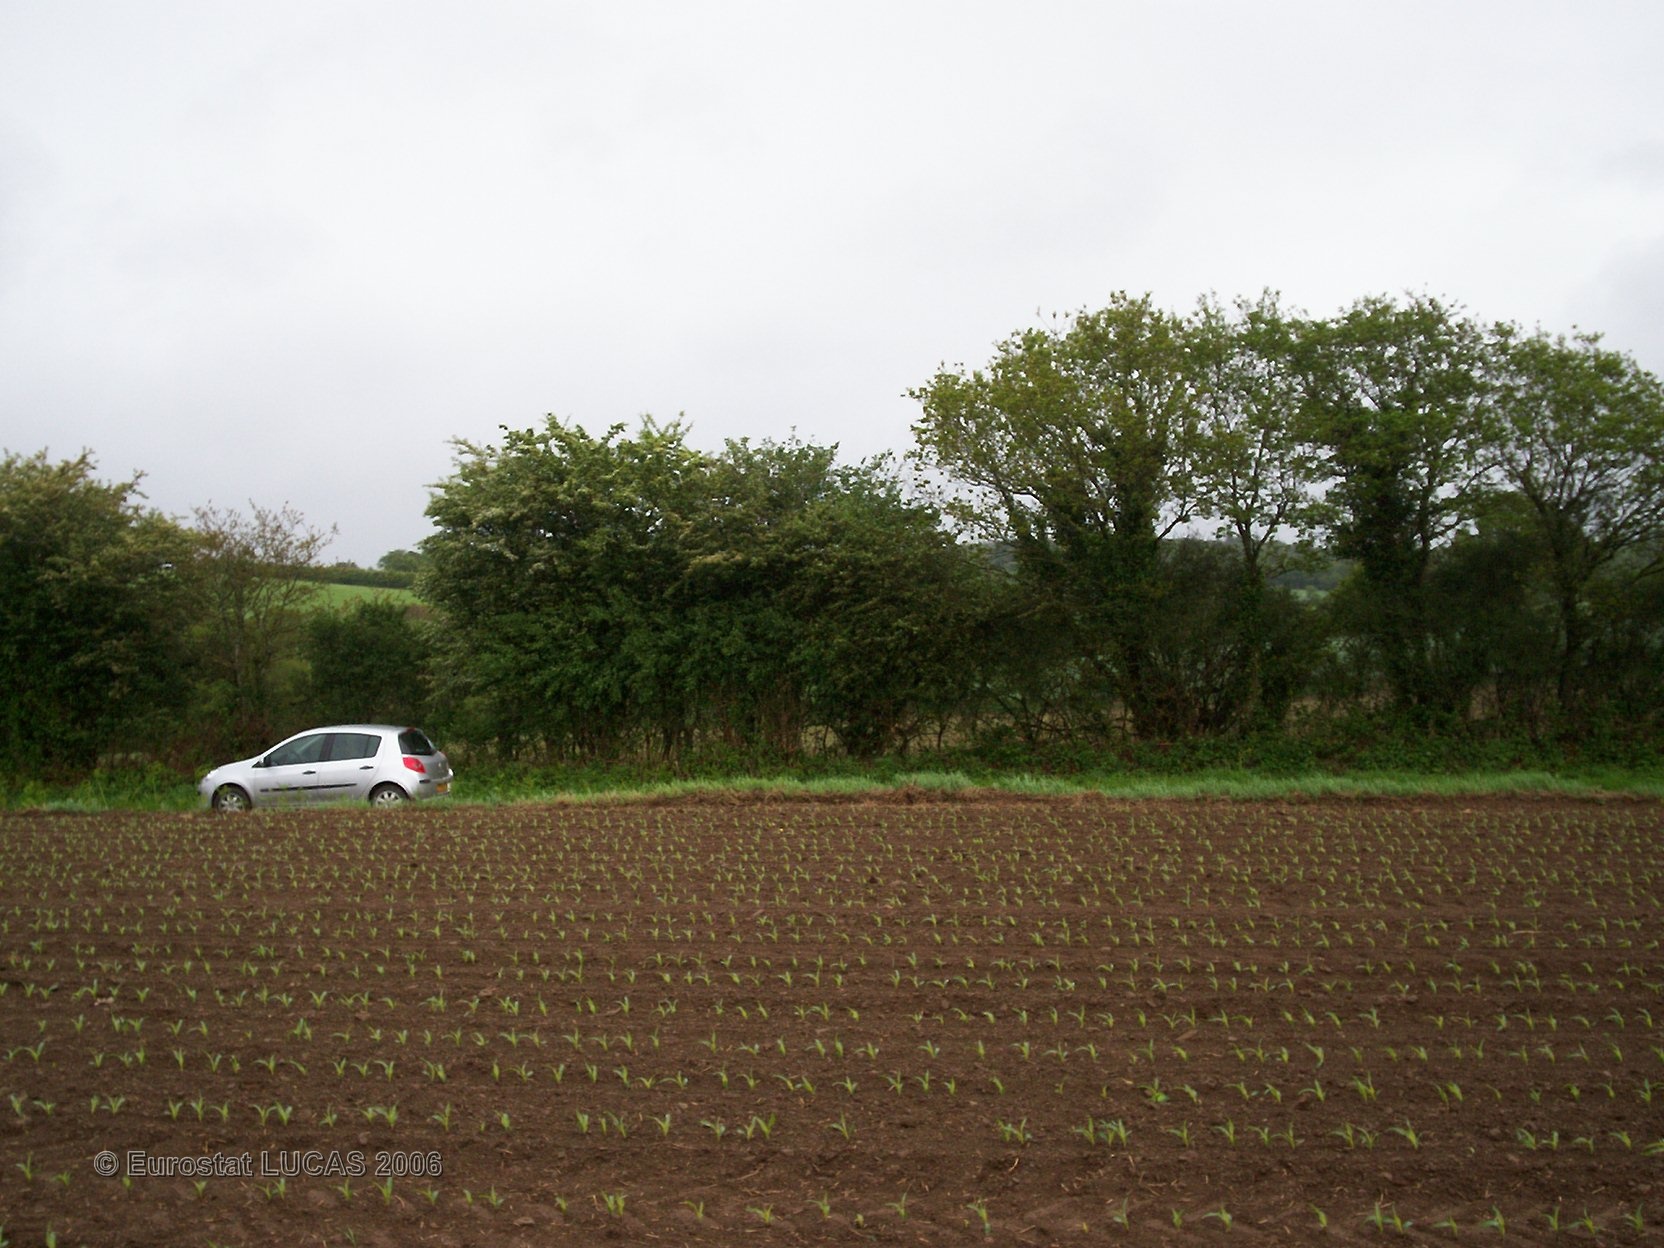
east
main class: Cropland
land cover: Maize
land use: Agriculture (excluding fallow land and kitchen gardens)
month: May
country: FR
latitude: 48.2994
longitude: -3.6560
